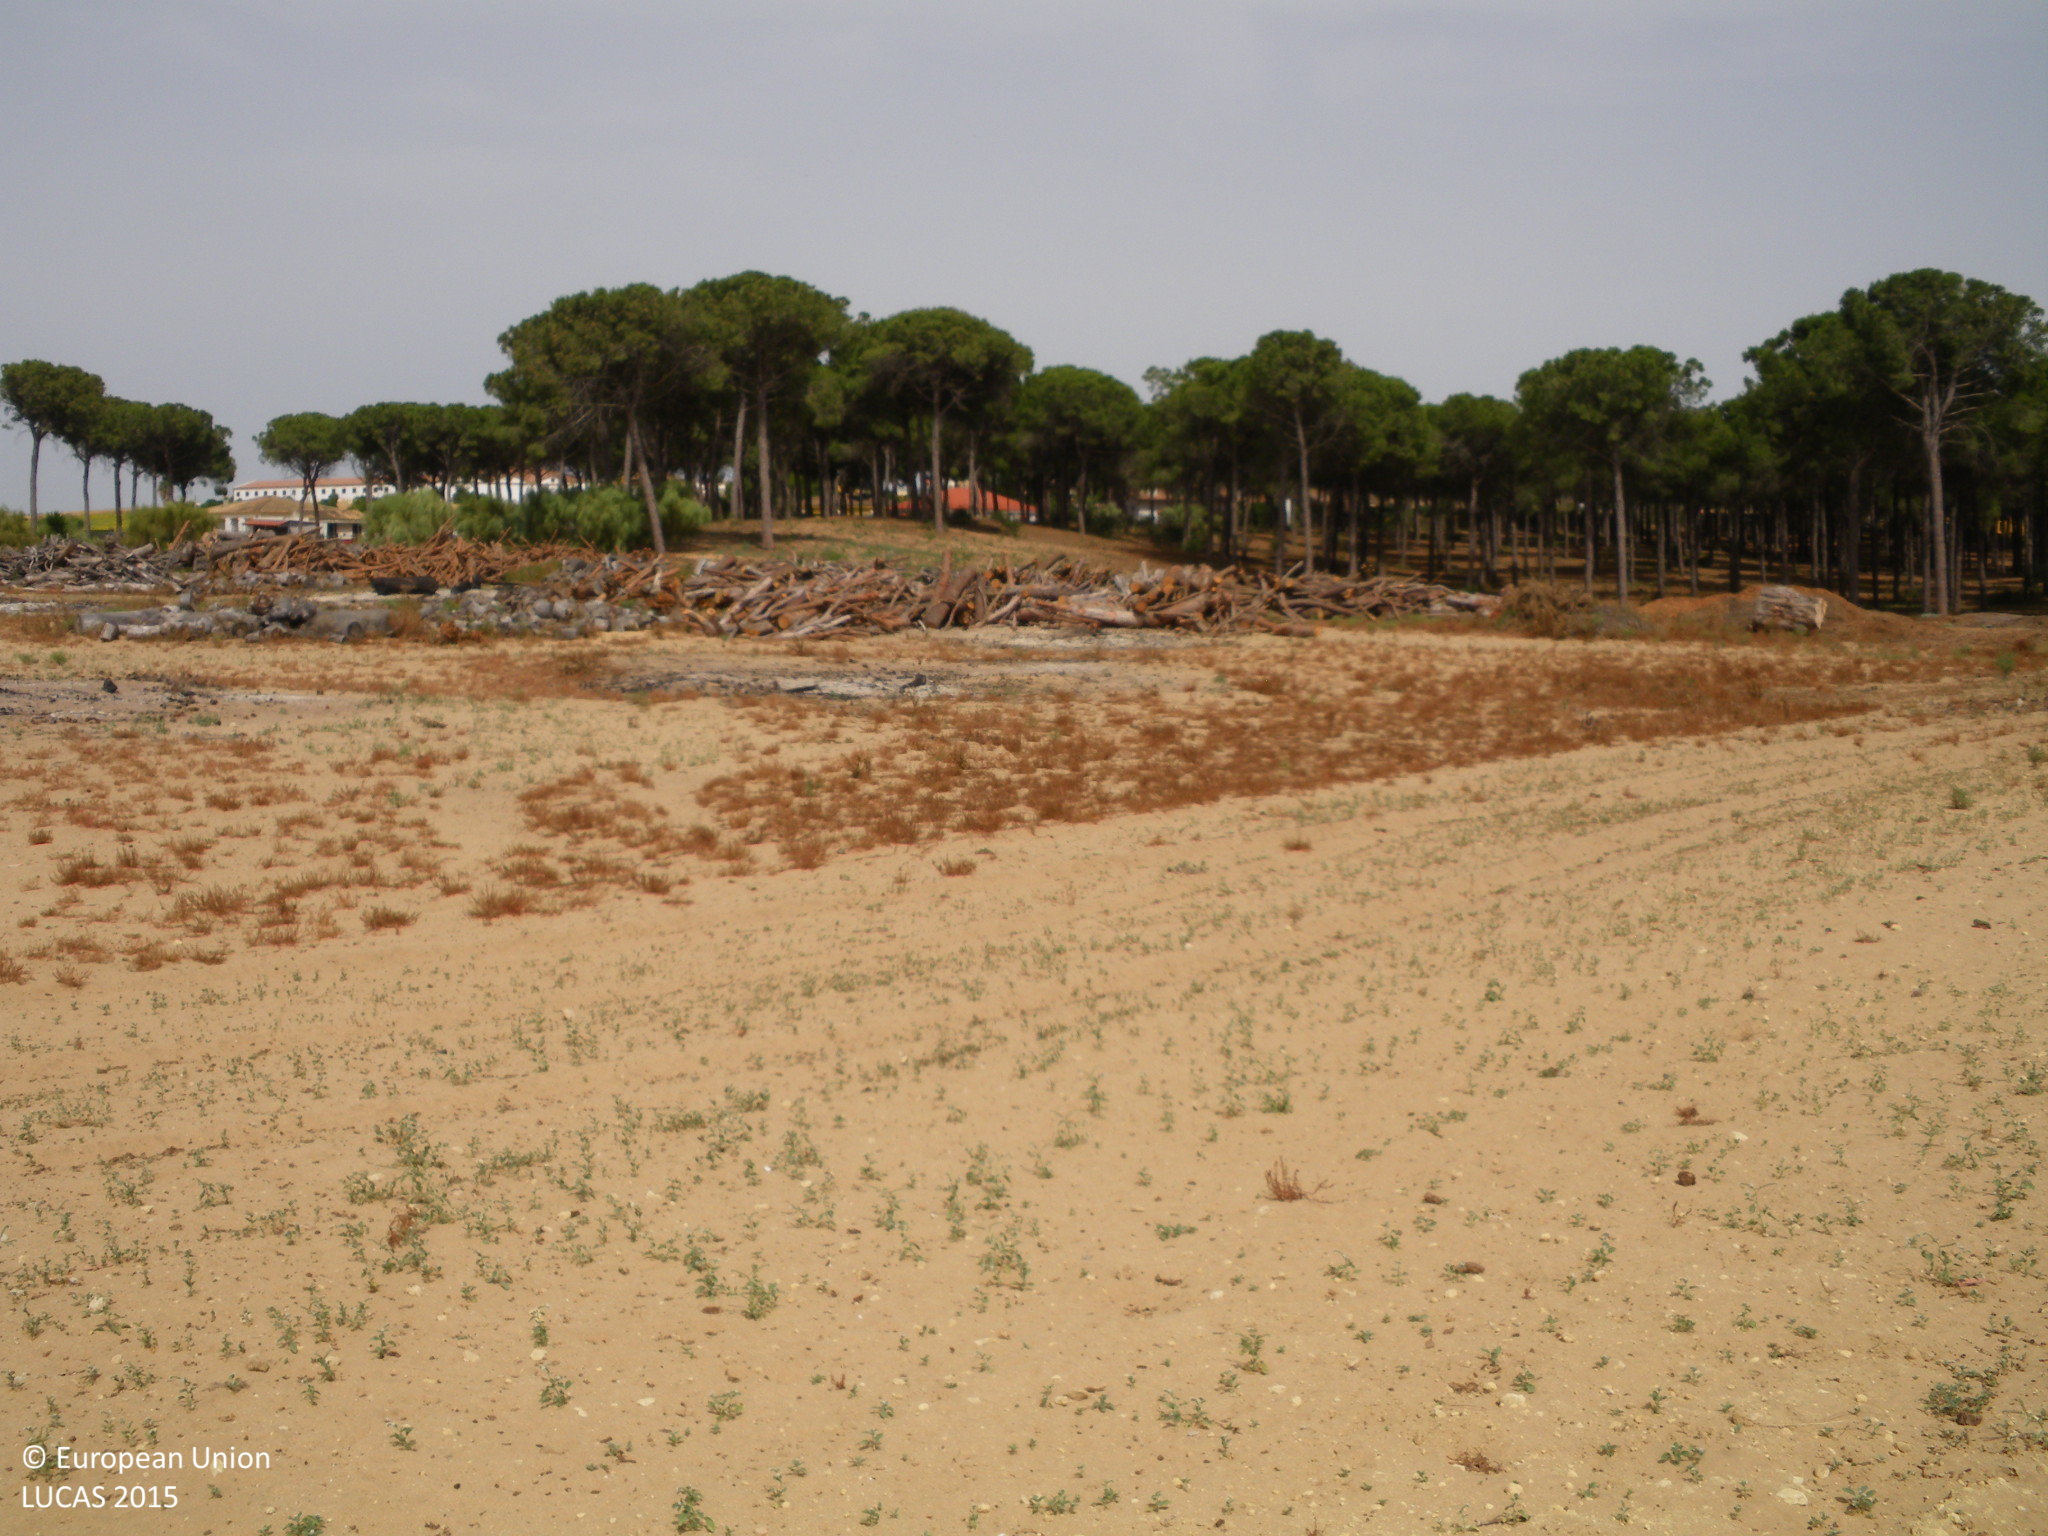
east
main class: Grassland
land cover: Grassland without tree/shrub cover
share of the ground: 10 - 25 %
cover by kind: unconsolidated bare surface 85 %, herbaceous plants 15 %
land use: Semi-natural and natural areas not in use
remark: Clear cut
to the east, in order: Grassland without tree/shrub cover; Other bare soil; Tracks; Pine dominated coniferous woodland; Fences; Artificial constructions in urban areas
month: June
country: ES
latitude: 36.6150
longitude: -6.2586
